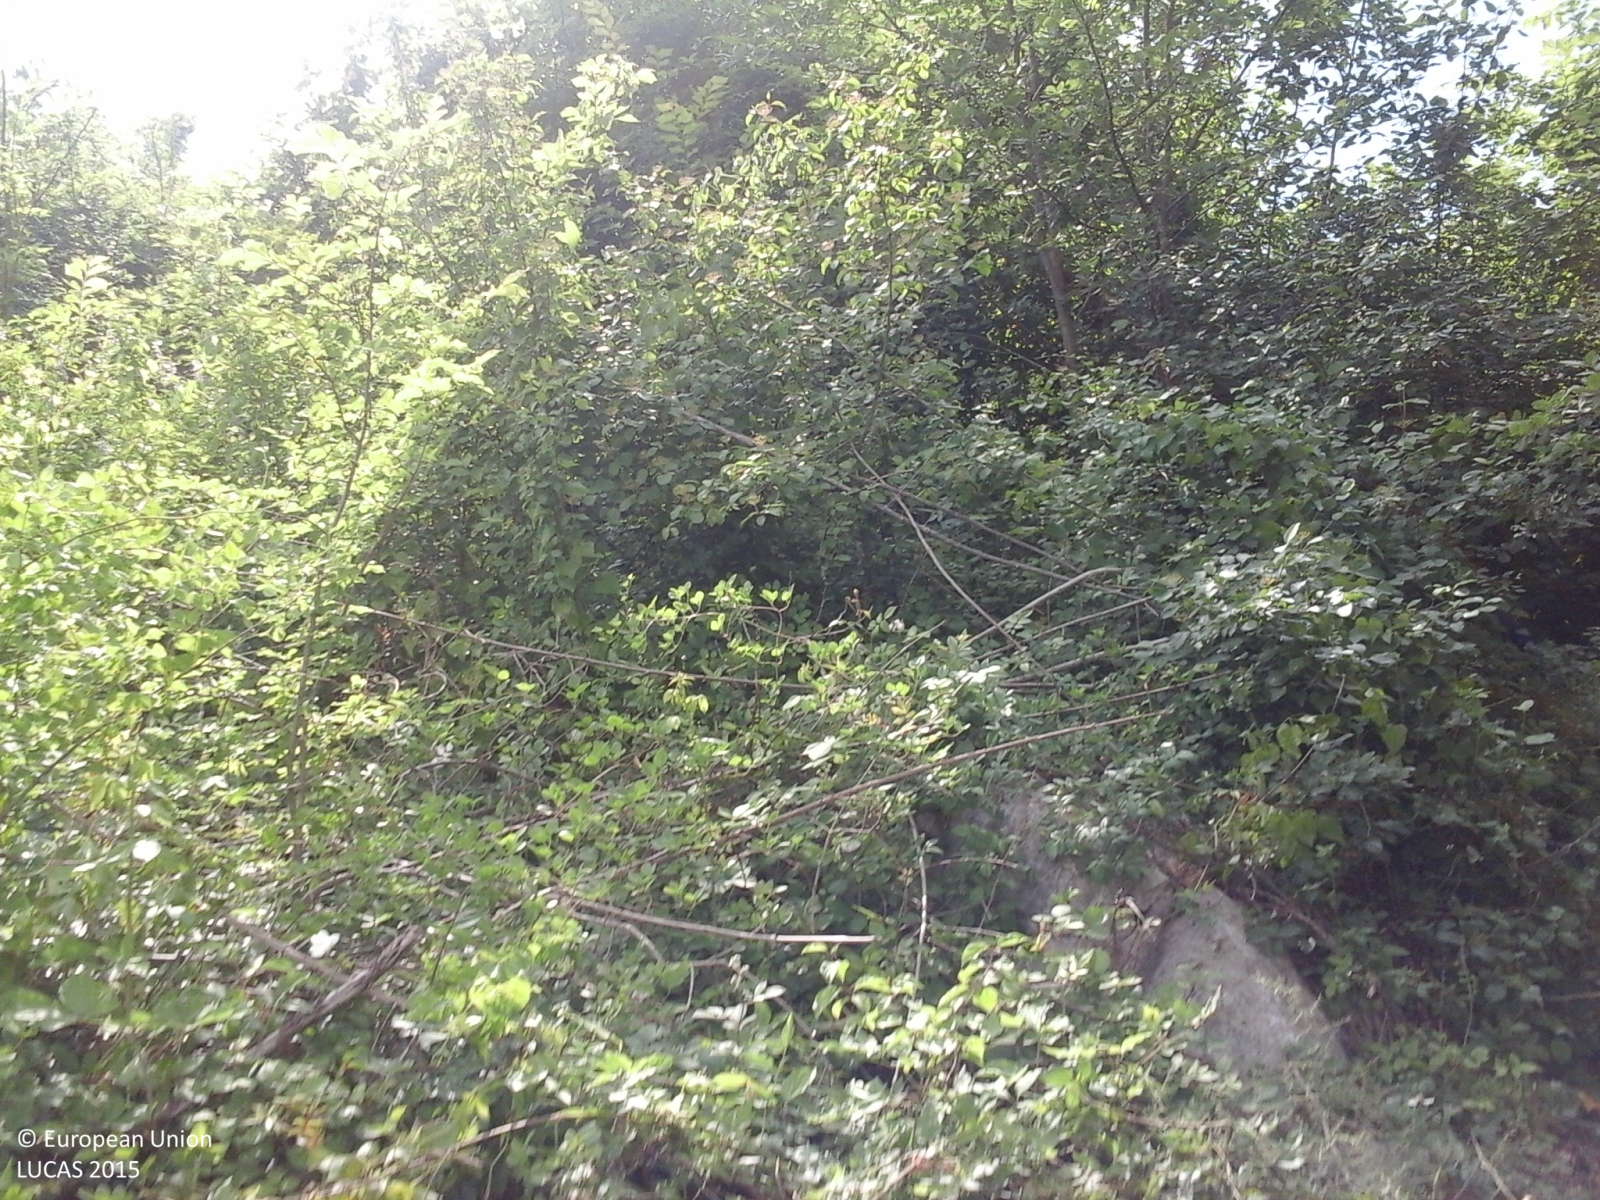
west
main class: Shrubland
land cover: Shrubland with sparse tree cover
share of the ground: 25 - 50 %
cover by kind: shrubs 55 %, herbaceous plants 40 %, broadleaved forest trees 5 %
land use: Agriculture (excluding fallow land and kitchen gardens)
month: June
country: IT
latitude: 41.6814
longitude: 13.7225
